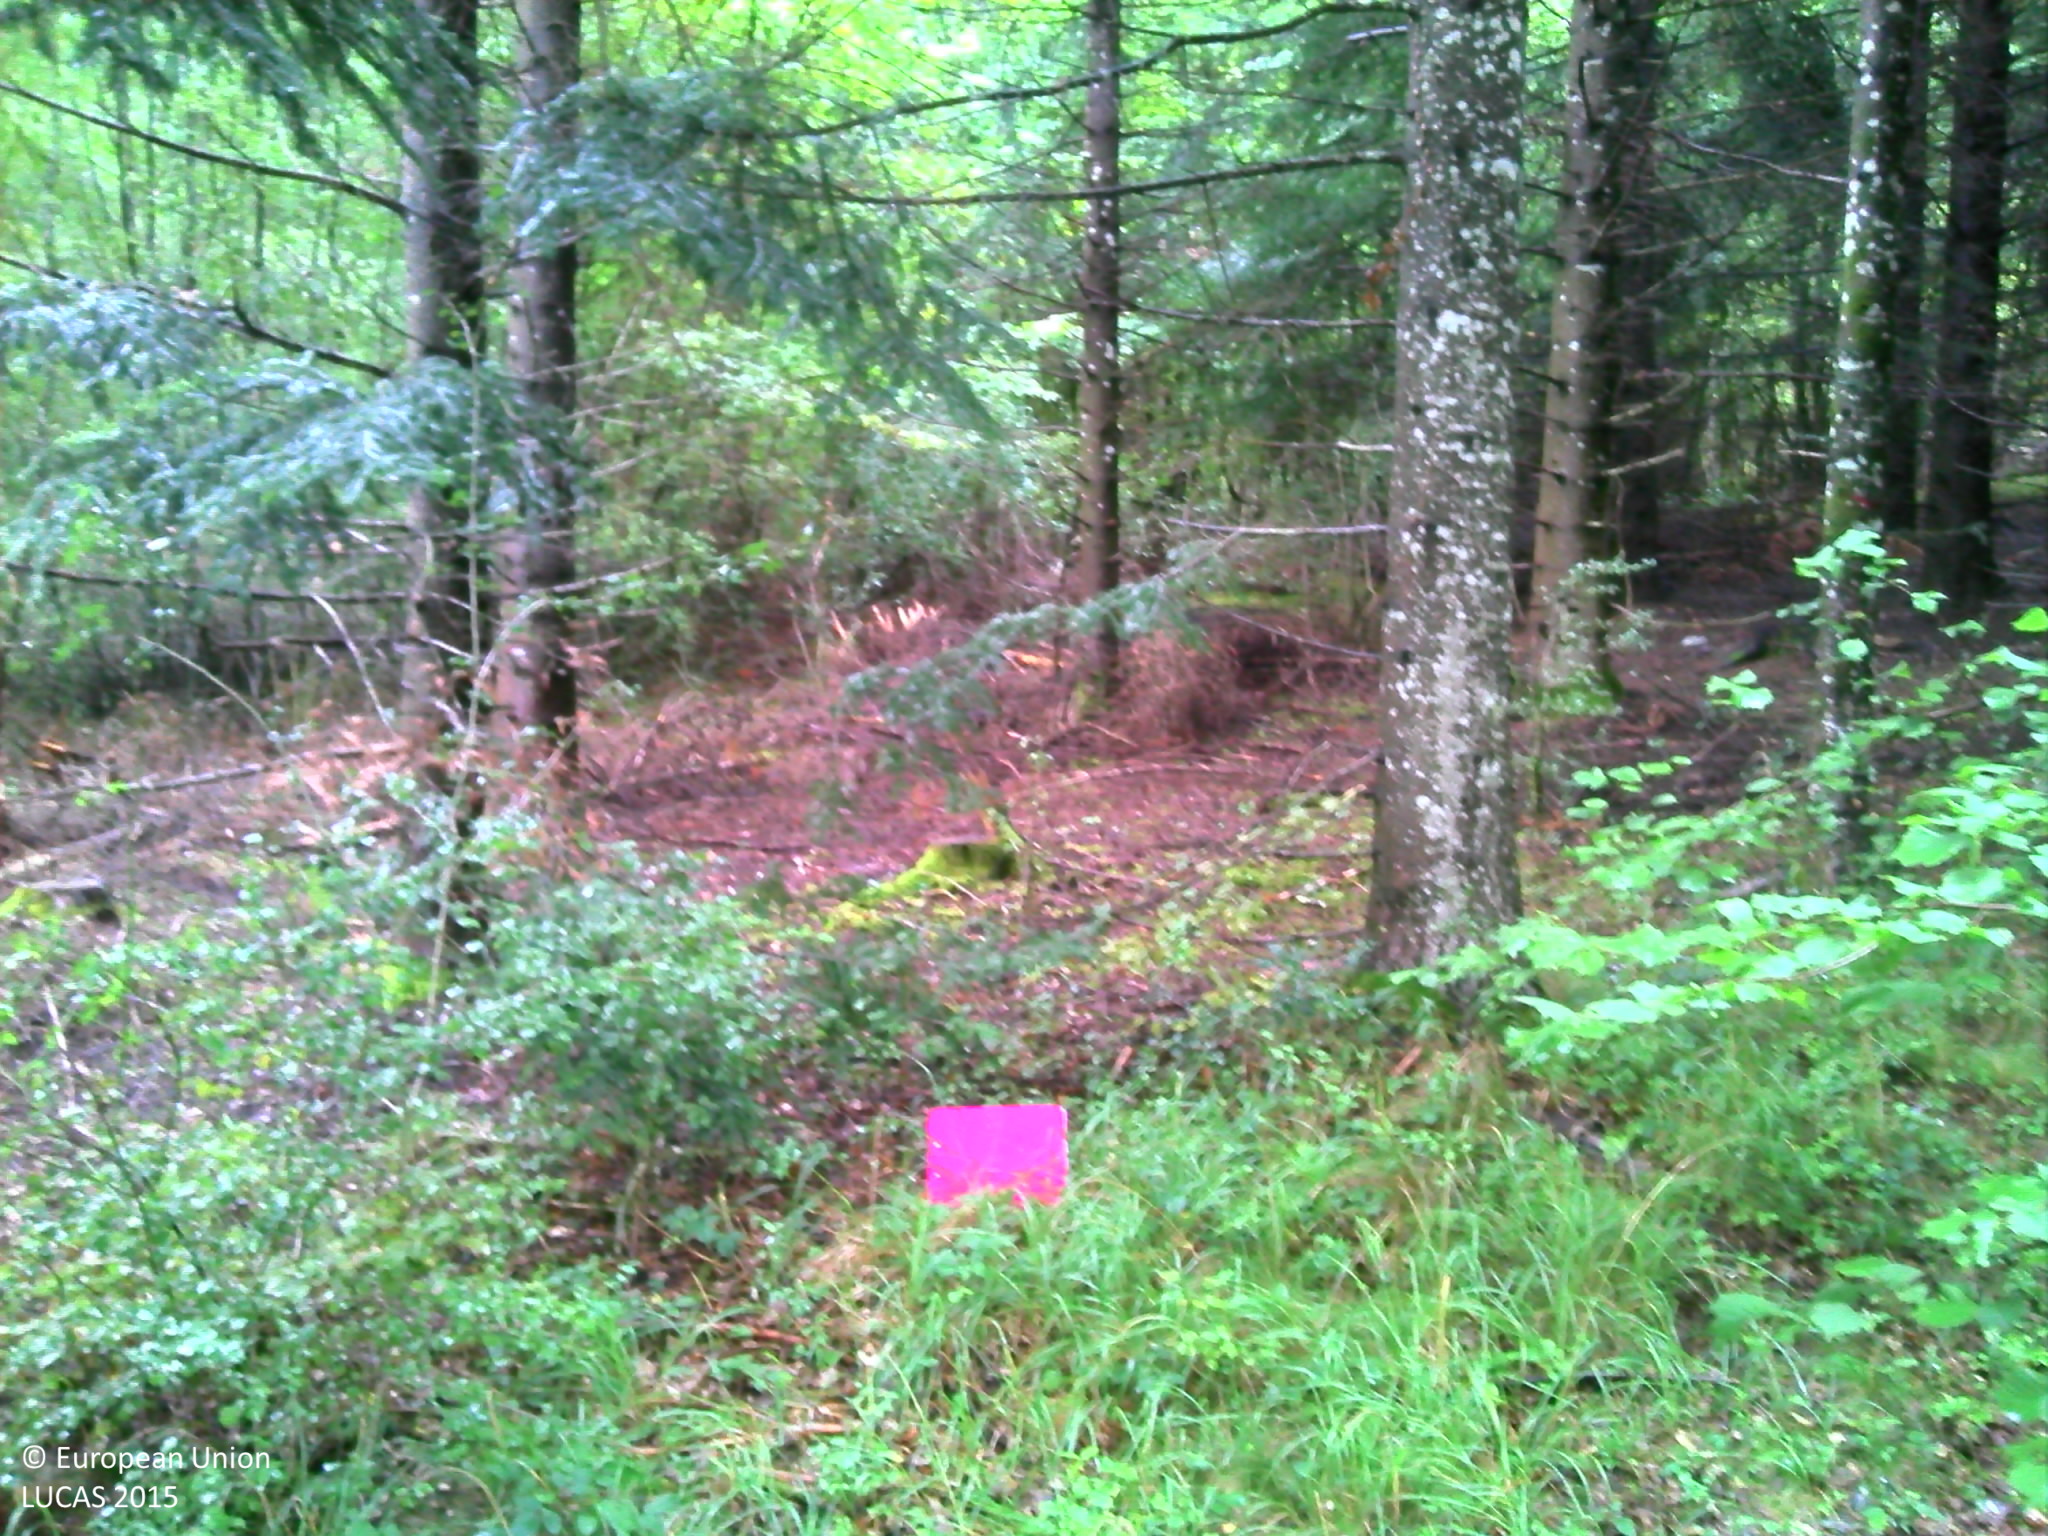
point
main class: Woodland
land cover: Other mixed woodland
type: exotic forest
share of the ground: > 75 %
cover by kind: coniferous forest trees 40 %, broadleaved forest trees 40 %, shrubs 10 %, herbaceous plants 10 %
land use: Forestry
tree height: > 5 m
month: September
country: FR
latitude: 47.1613
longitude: 4.7636
